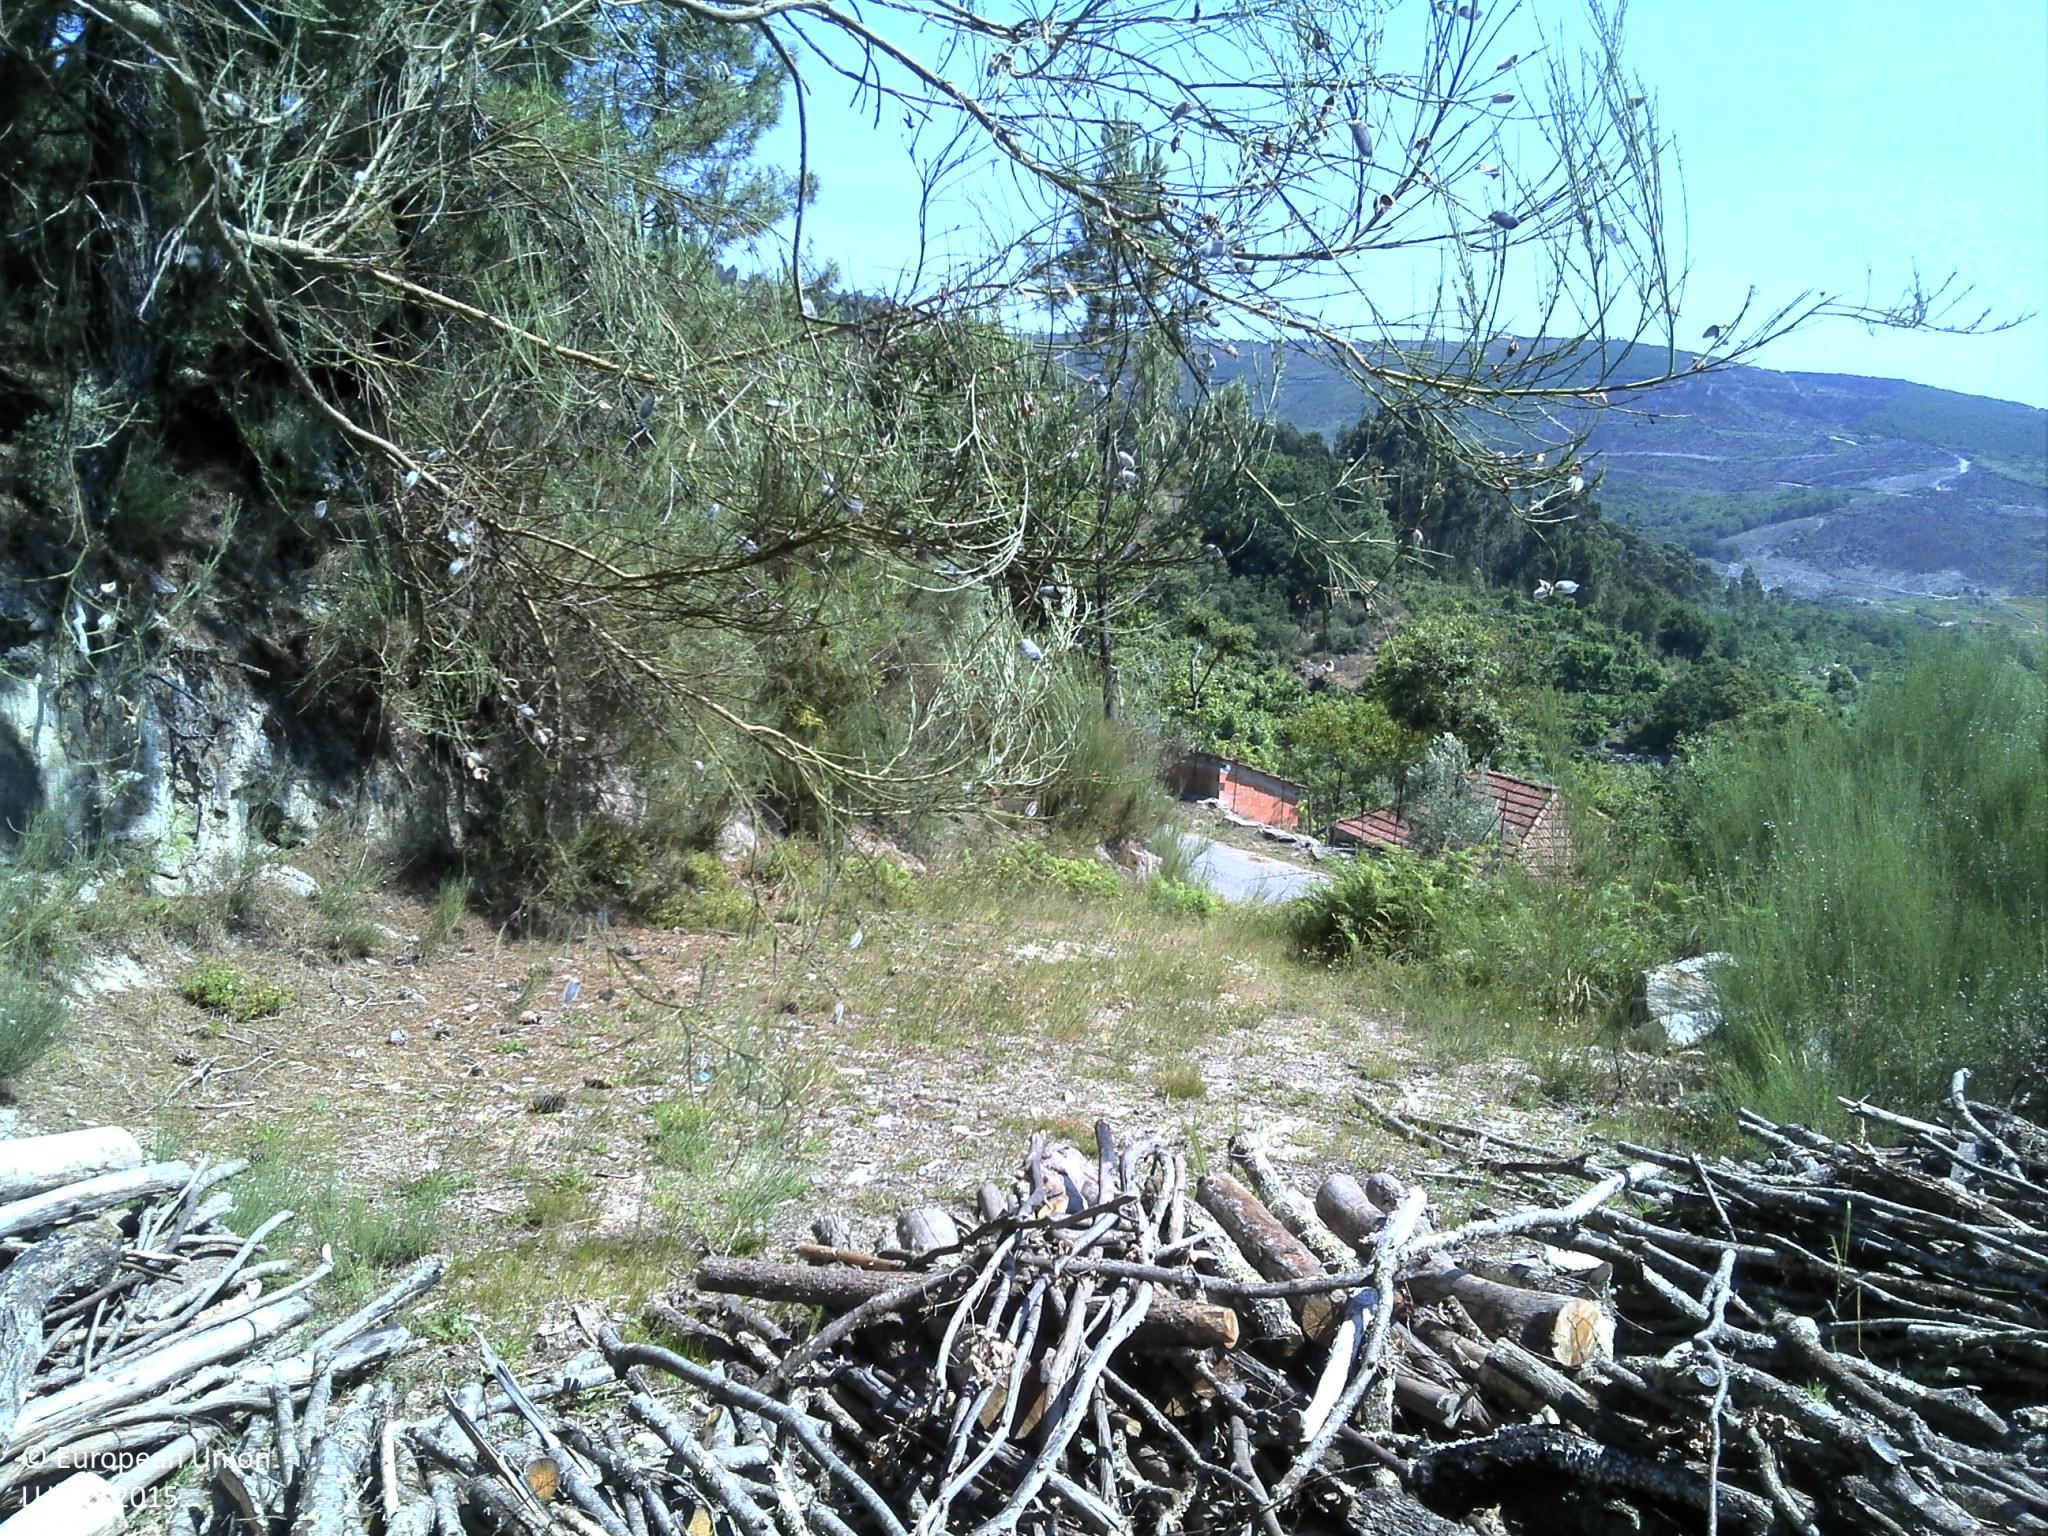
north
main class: Woodland
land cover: Pine dominated coniferous woodland
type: coniferous forest of the mediterranean region
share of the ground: 50 - 75 %
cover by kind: coniferous forest trees 65 %, shrubs 30 %, unconsolidated bare surface 5 %
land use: Semi-natural and natural areas not in use
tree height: > 5 m
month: July
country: PT
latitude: 41.5523
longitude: -7.8453
